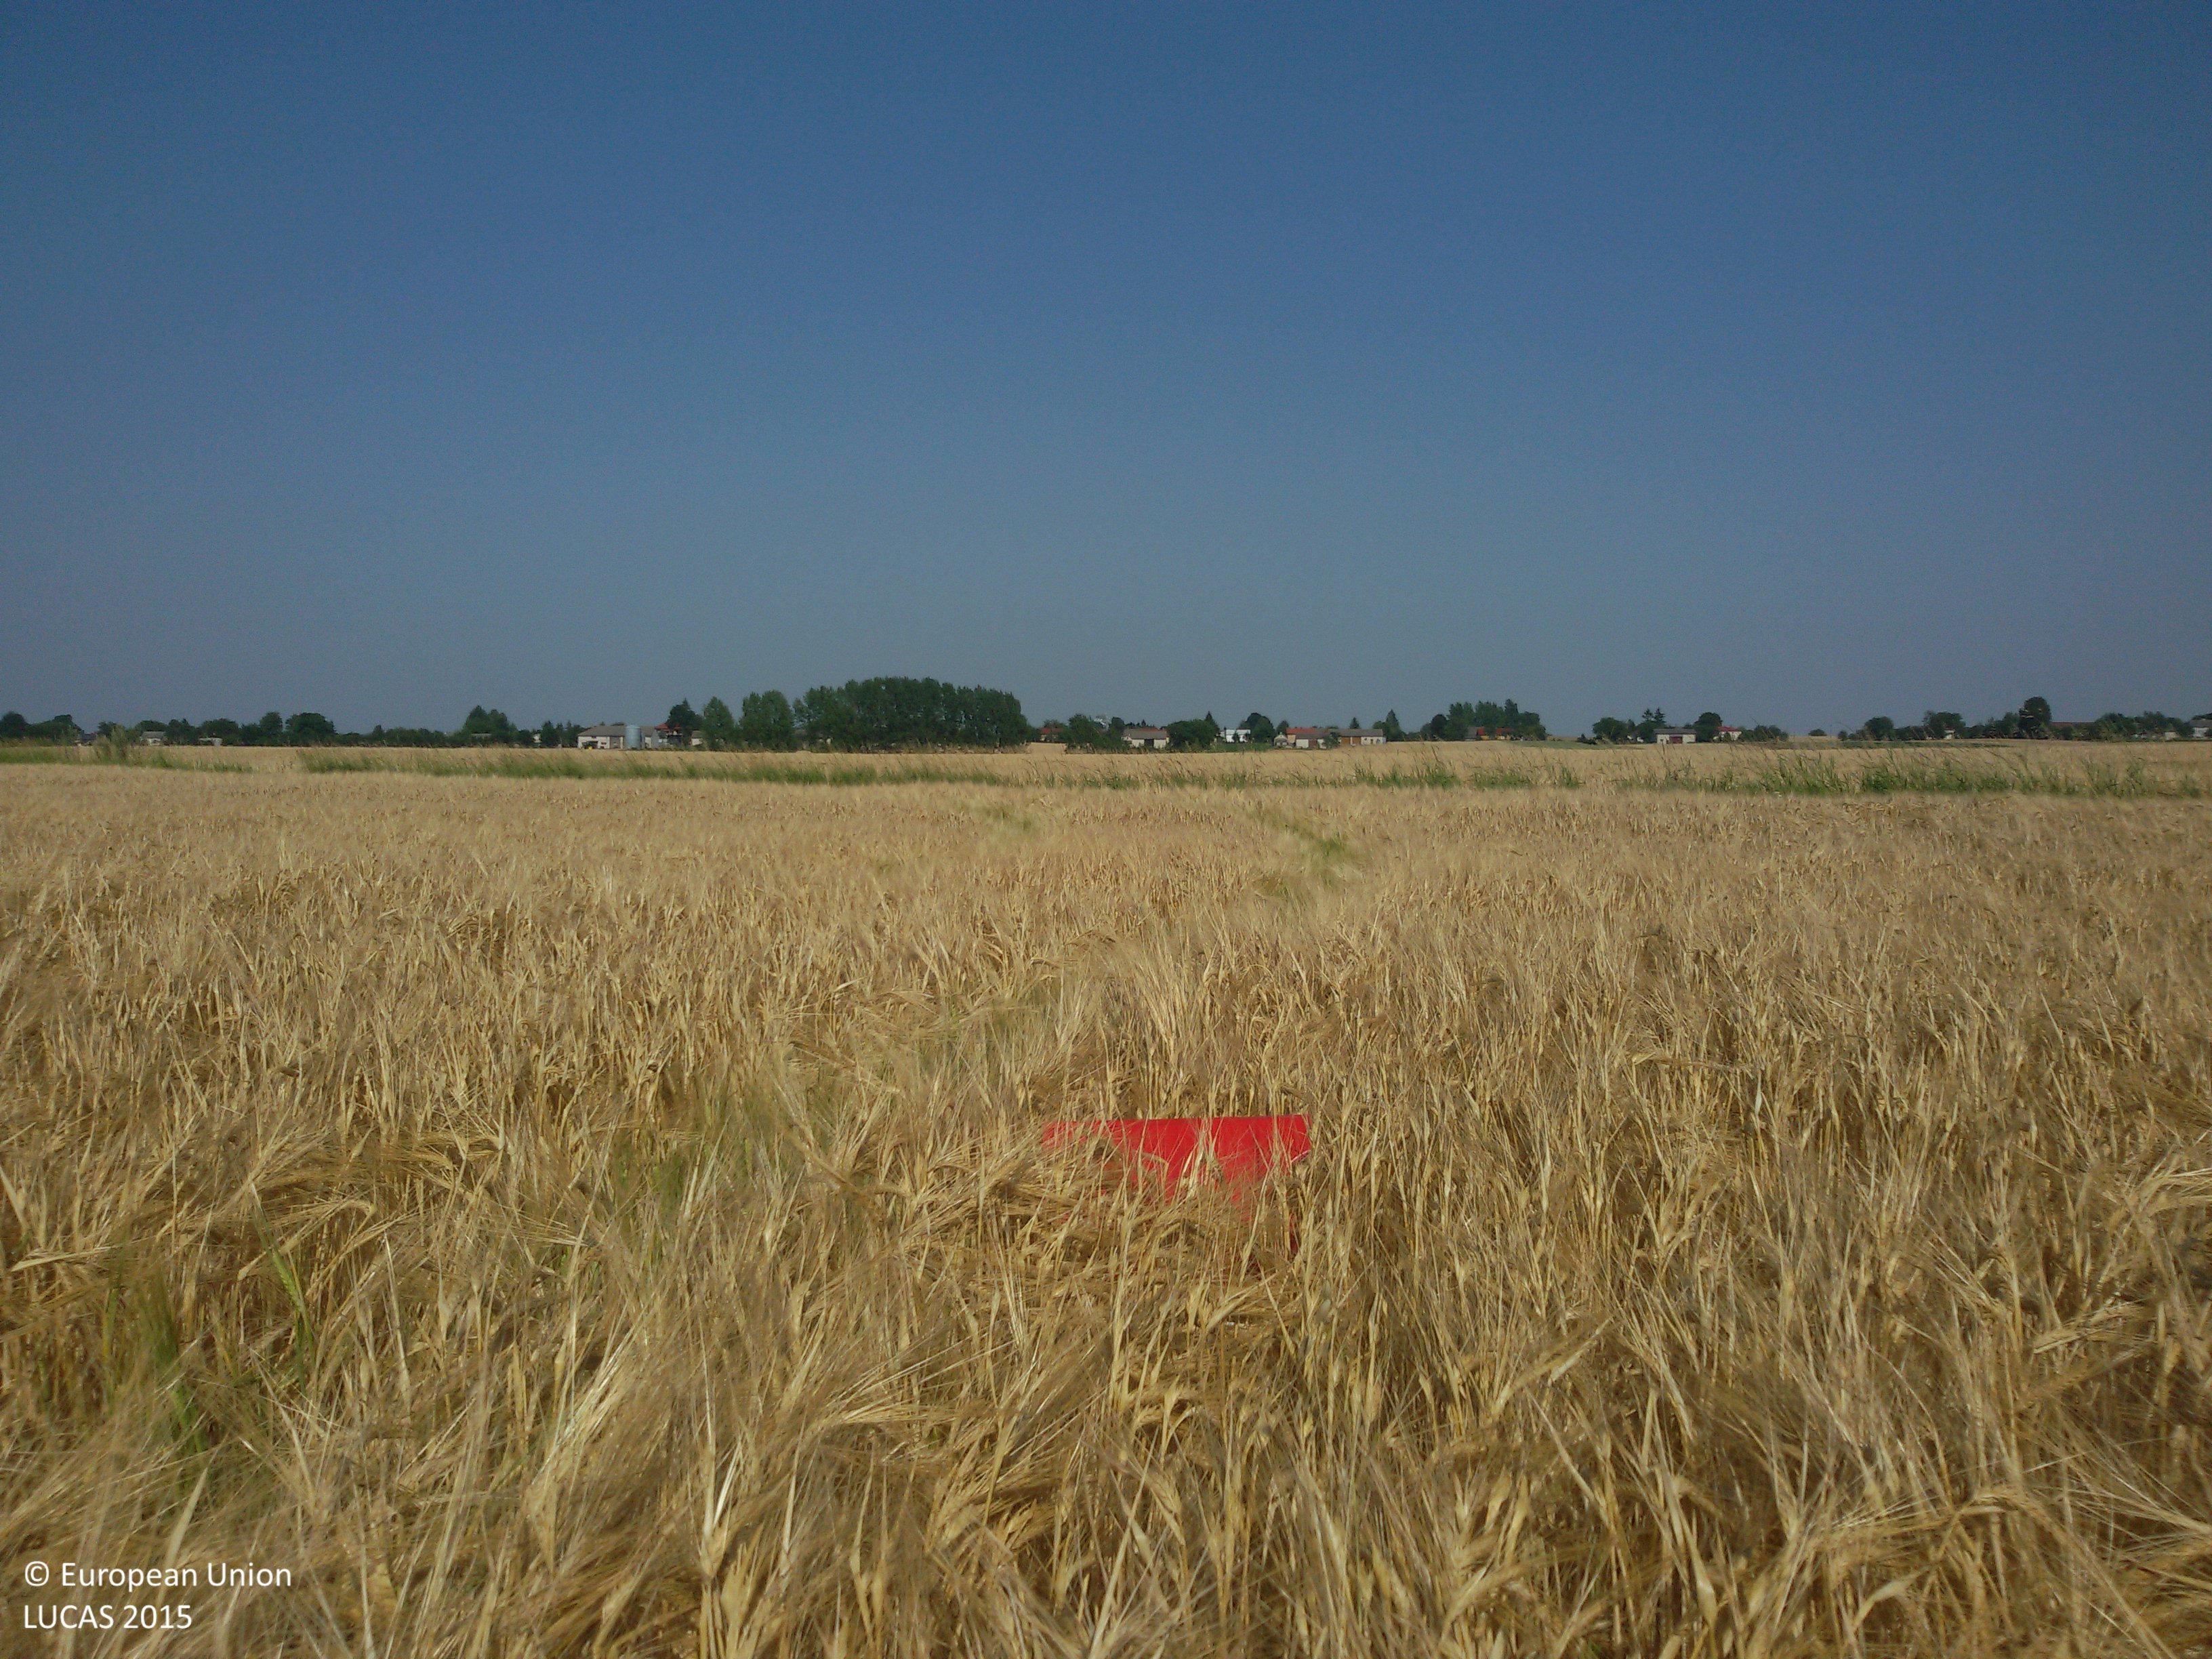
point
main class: Cropland
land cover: Barley
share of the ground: > 75 %
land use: Agriculture (excluding fallow land and kitchen gardens)
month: July
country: PL
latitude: 50.8662
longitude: 24.0046
